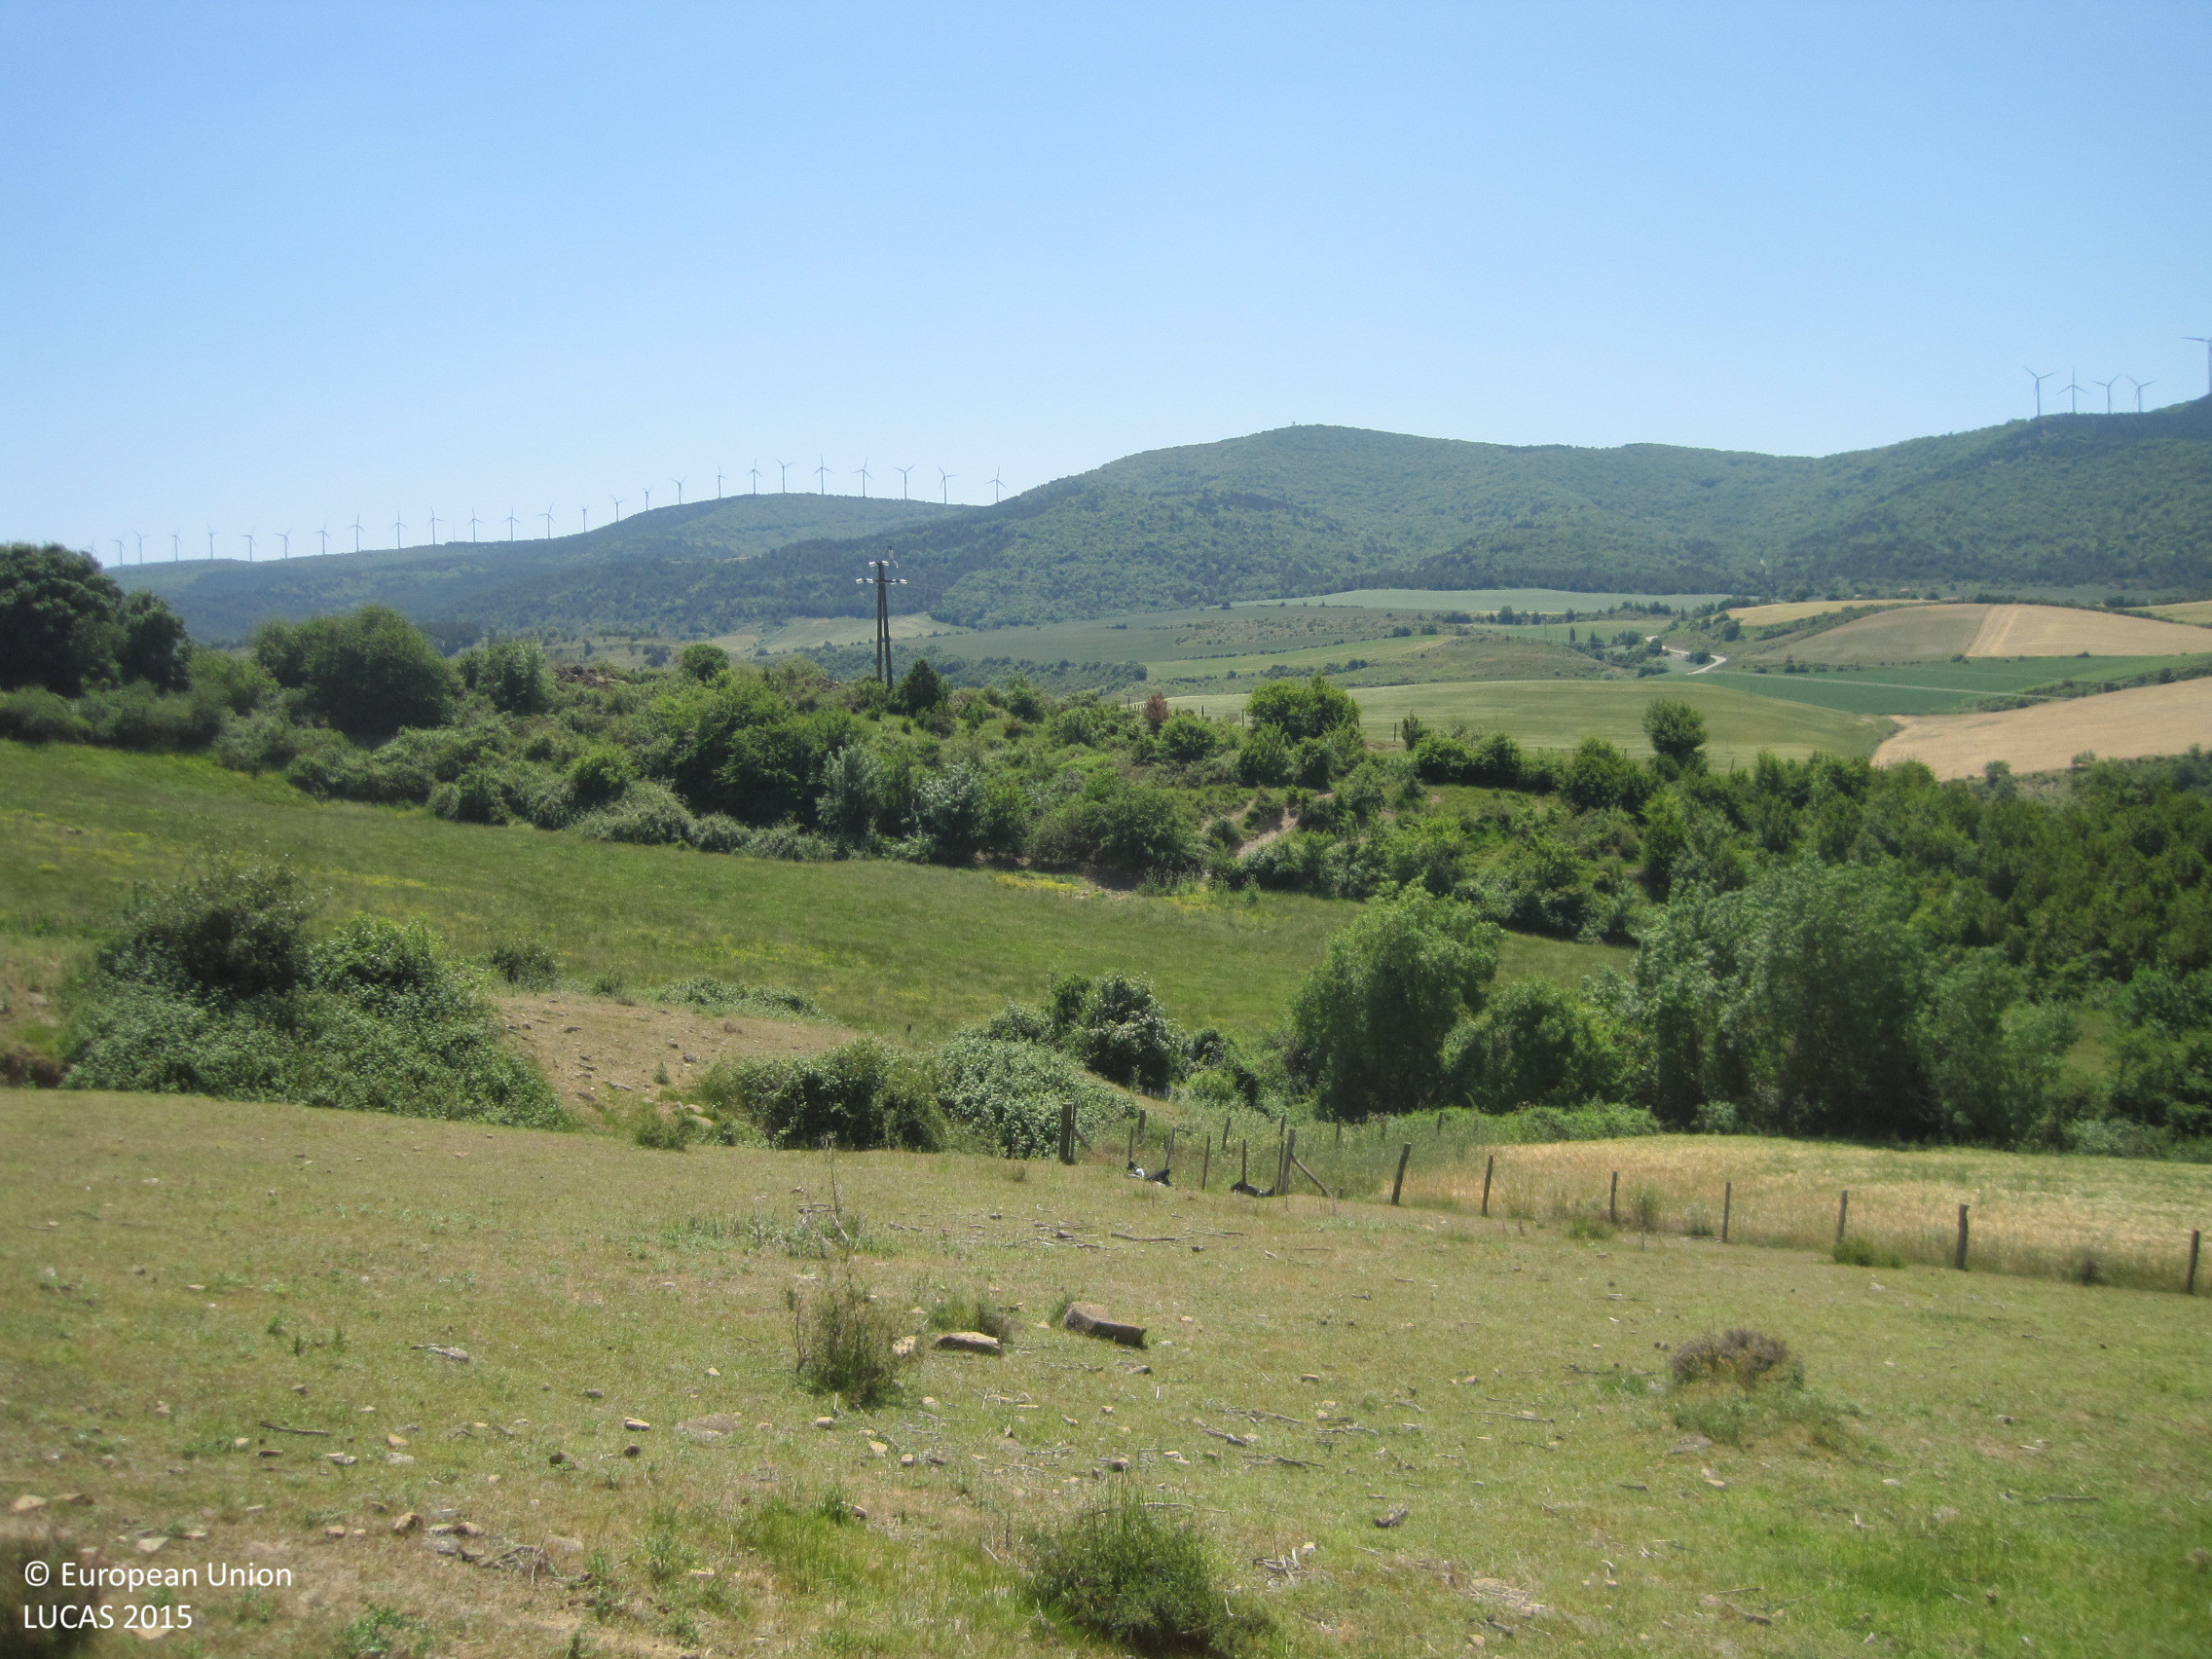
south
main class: Grassland
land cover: Grassland without tree/shrub cover
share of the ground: > 75 %
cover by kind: herbaceous plants 50 %, unconsolidated bare surface 45 %, shrubs 5 %
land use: Agriculture (excluding fallow land and kitchen gardens)
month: June
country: ES
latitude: 42.6771
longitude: -1.4457
